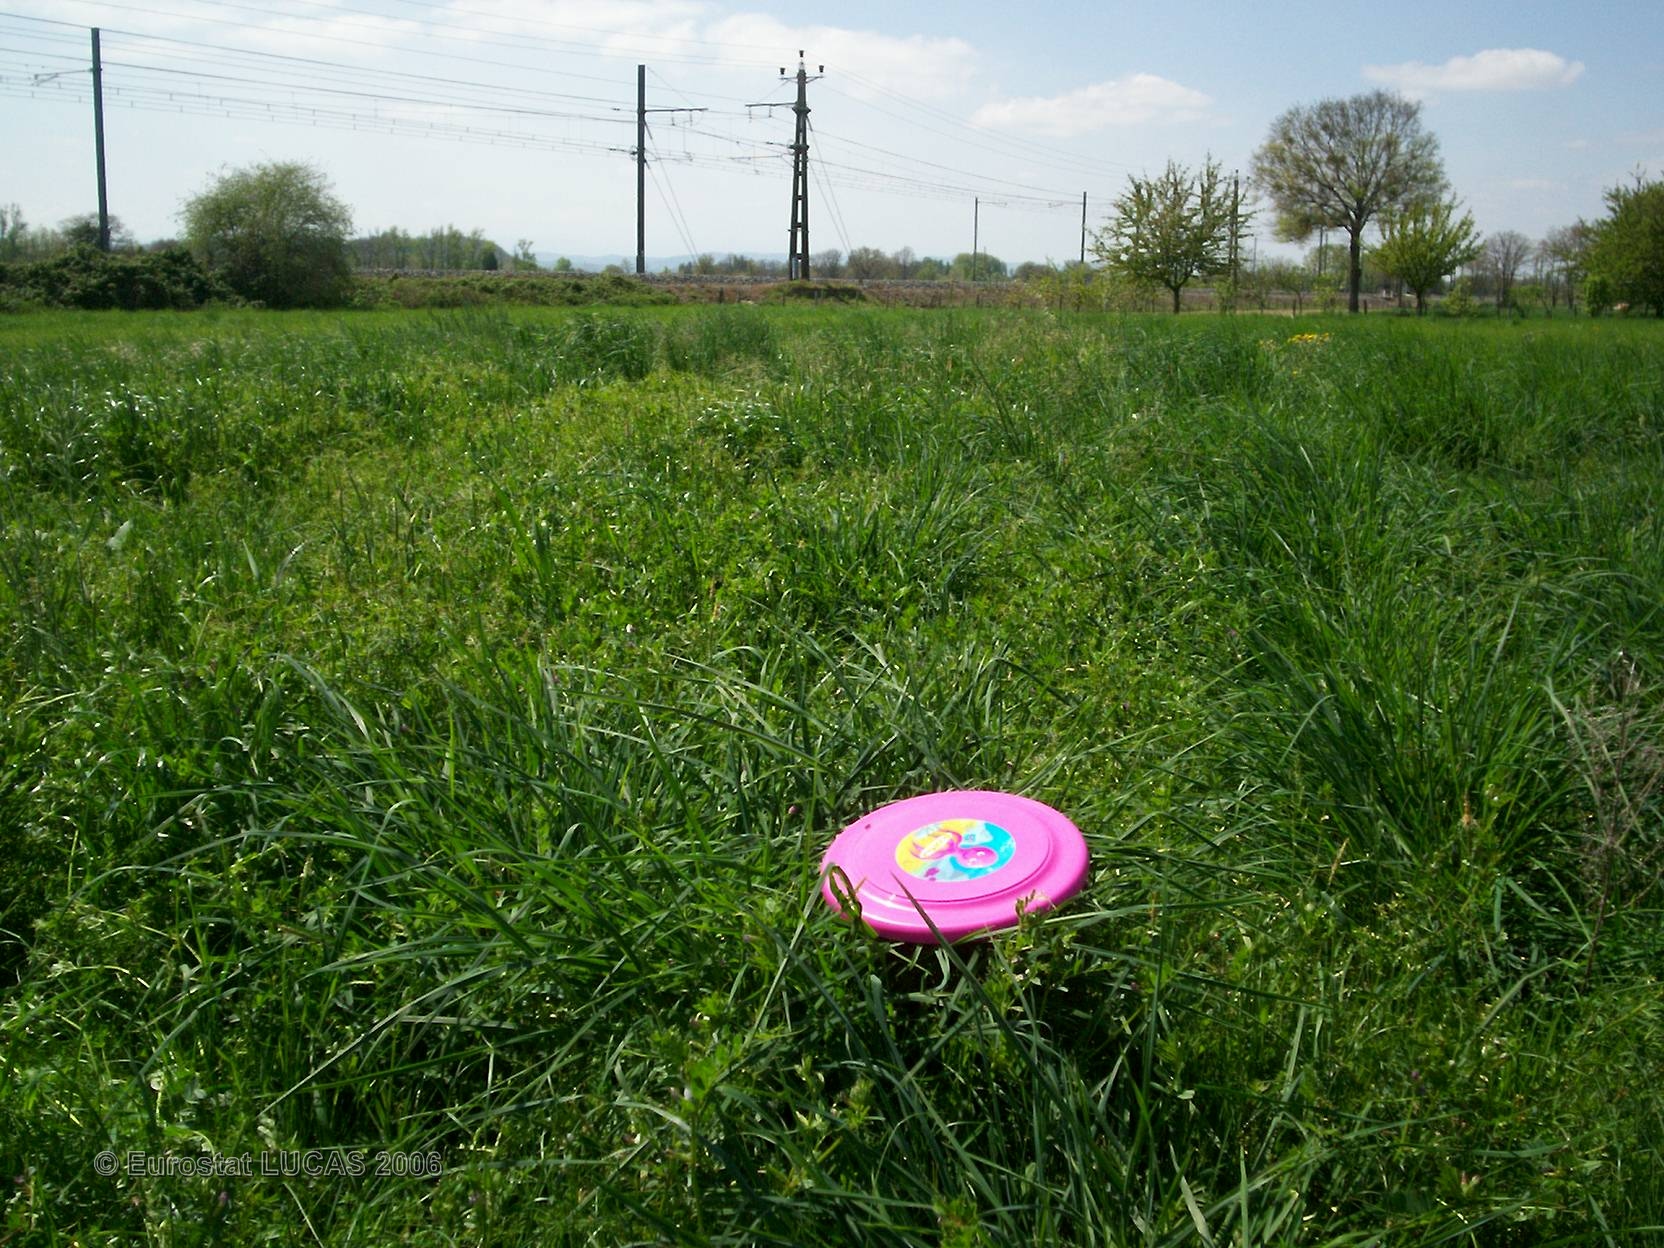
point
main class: Grassland
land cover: Grassland without tree/shrub cover
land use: Agriculture (excluding fallow land and kitchen gardens)
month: April
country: FR
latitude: 43.2861
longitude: 1.1915
